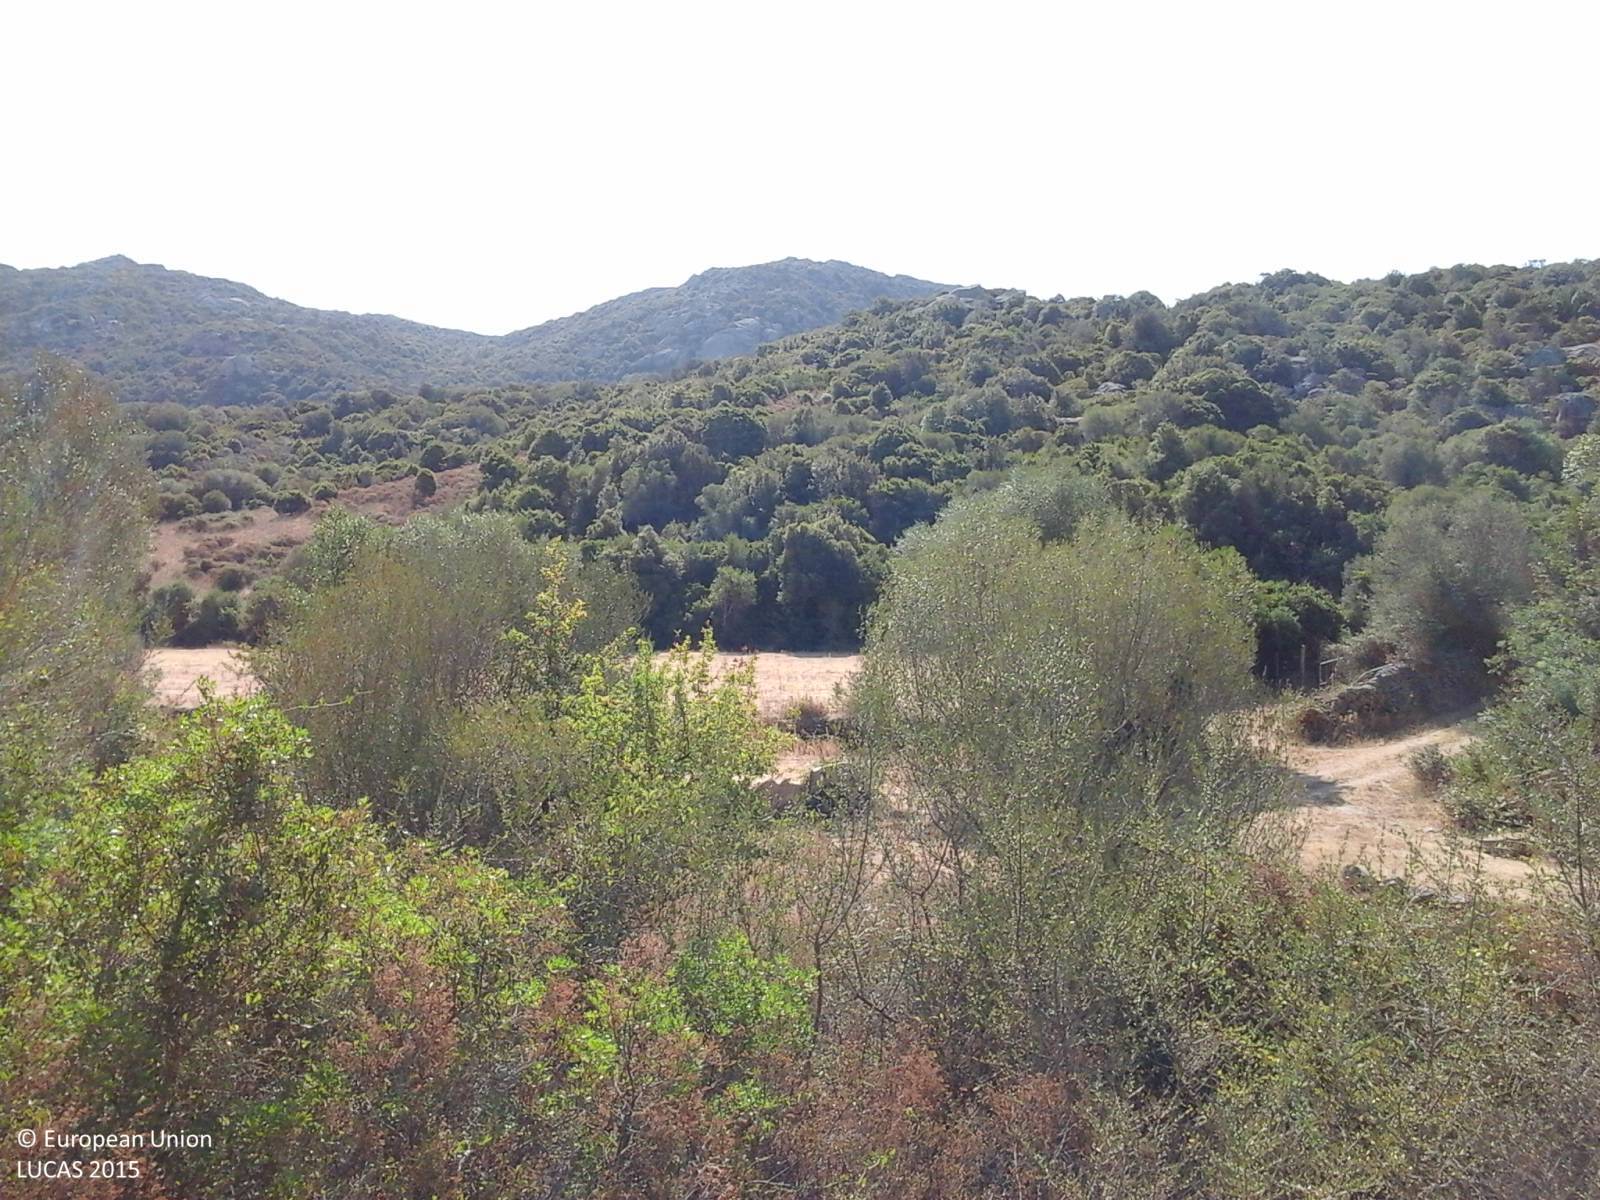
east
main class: Woodland
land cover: Broadleaved woodland
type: broadleaved evergreen forest
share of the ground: > 75 %
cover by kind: herbaceous plants 60 %, shrubs 30 %, broadleaved forest trees 10 %
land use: Semi-natural and natural areas not in use
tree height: > 5 m
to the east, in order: Broadleaved woodland; Grassland without tree/shrub cover; Shrubland with sparse tree cover; Ditches and canals; Dry stone walls; Tracks; Dry stone walls; Fences; Grassland without tree/shrub cover; Lines of trees; Fences; Shrubland without tree cover
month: July
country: IT
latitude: 41.1334
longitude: 9.3003
